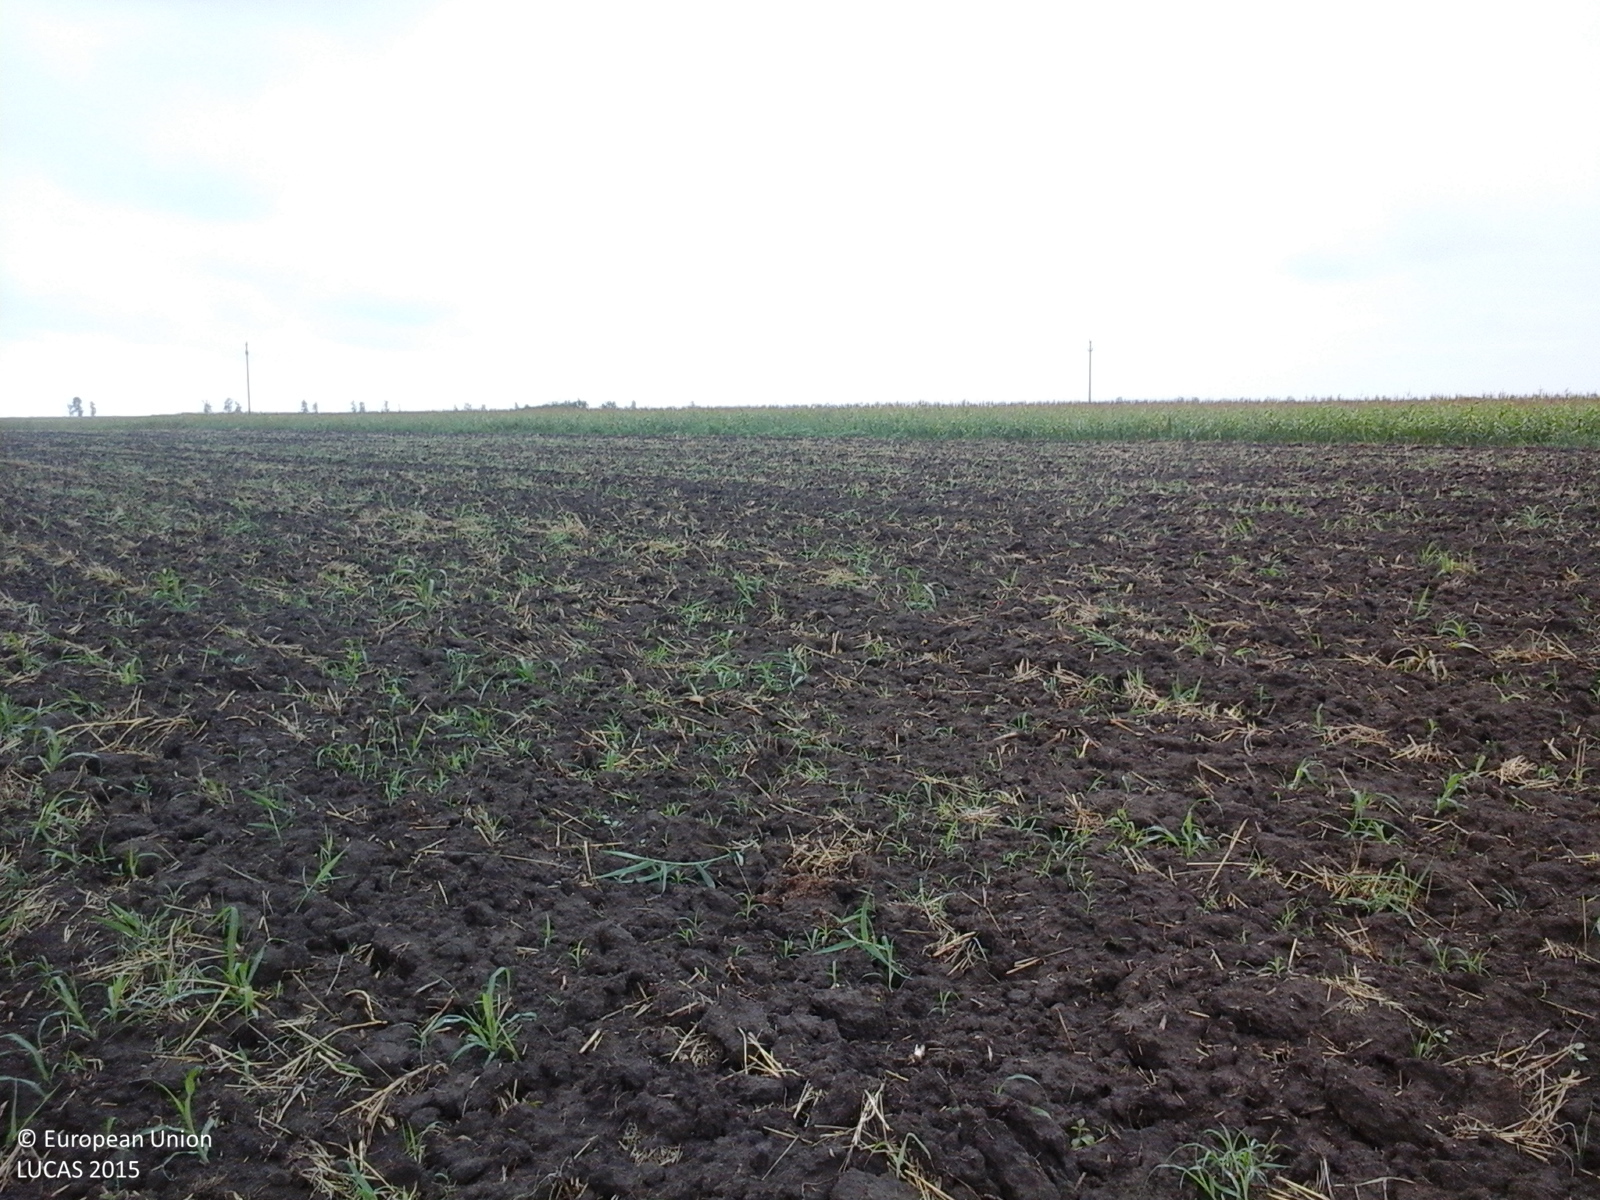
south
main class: Cropland
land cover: Common wheat
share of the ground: < 10 %
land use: Agriculture (excluding fallow land and kitchen gardens)
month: August
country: RO
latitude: 46.0375
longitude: 20.4512
